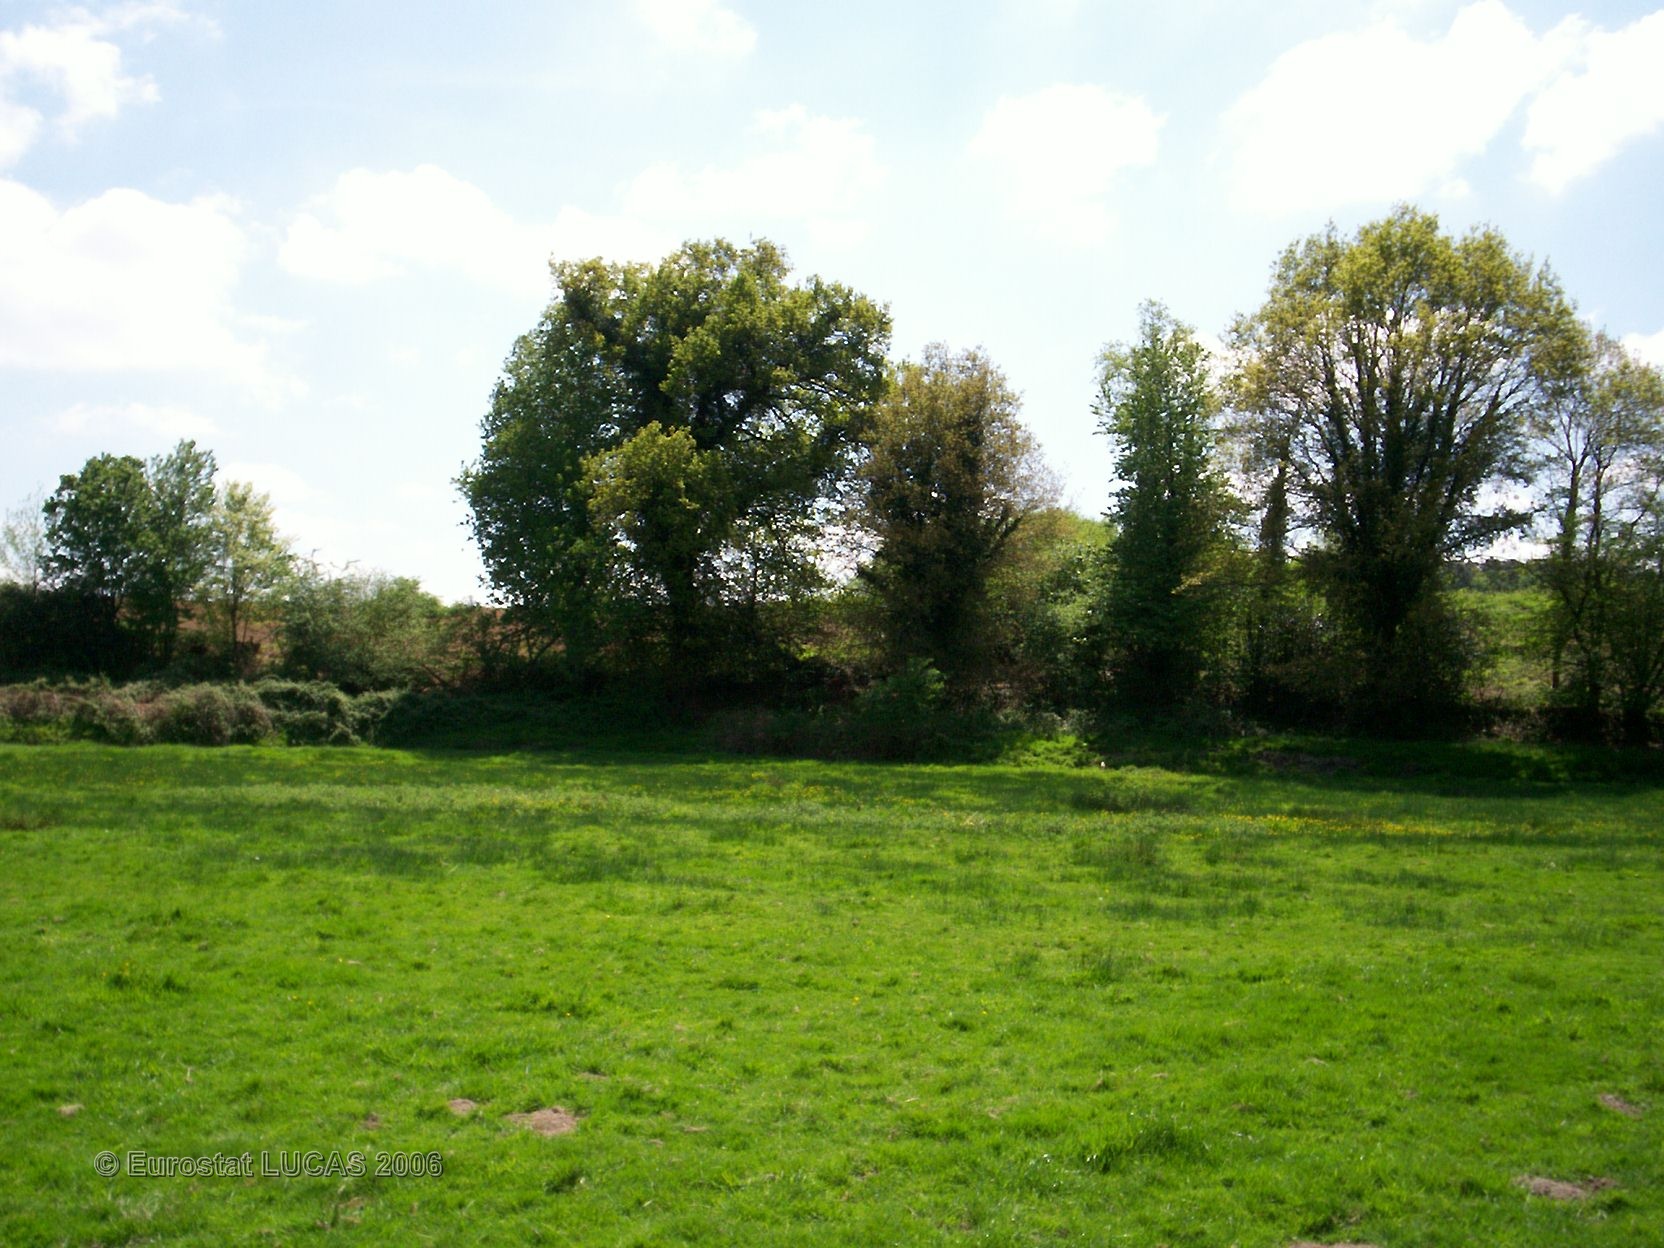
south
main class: Grassland
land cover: Grassland without tree/shrub cover
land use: Agriculture (excluding fallow land and kitchen gardens)
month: May
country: FR
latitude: 47.6099
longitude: -2.2526
